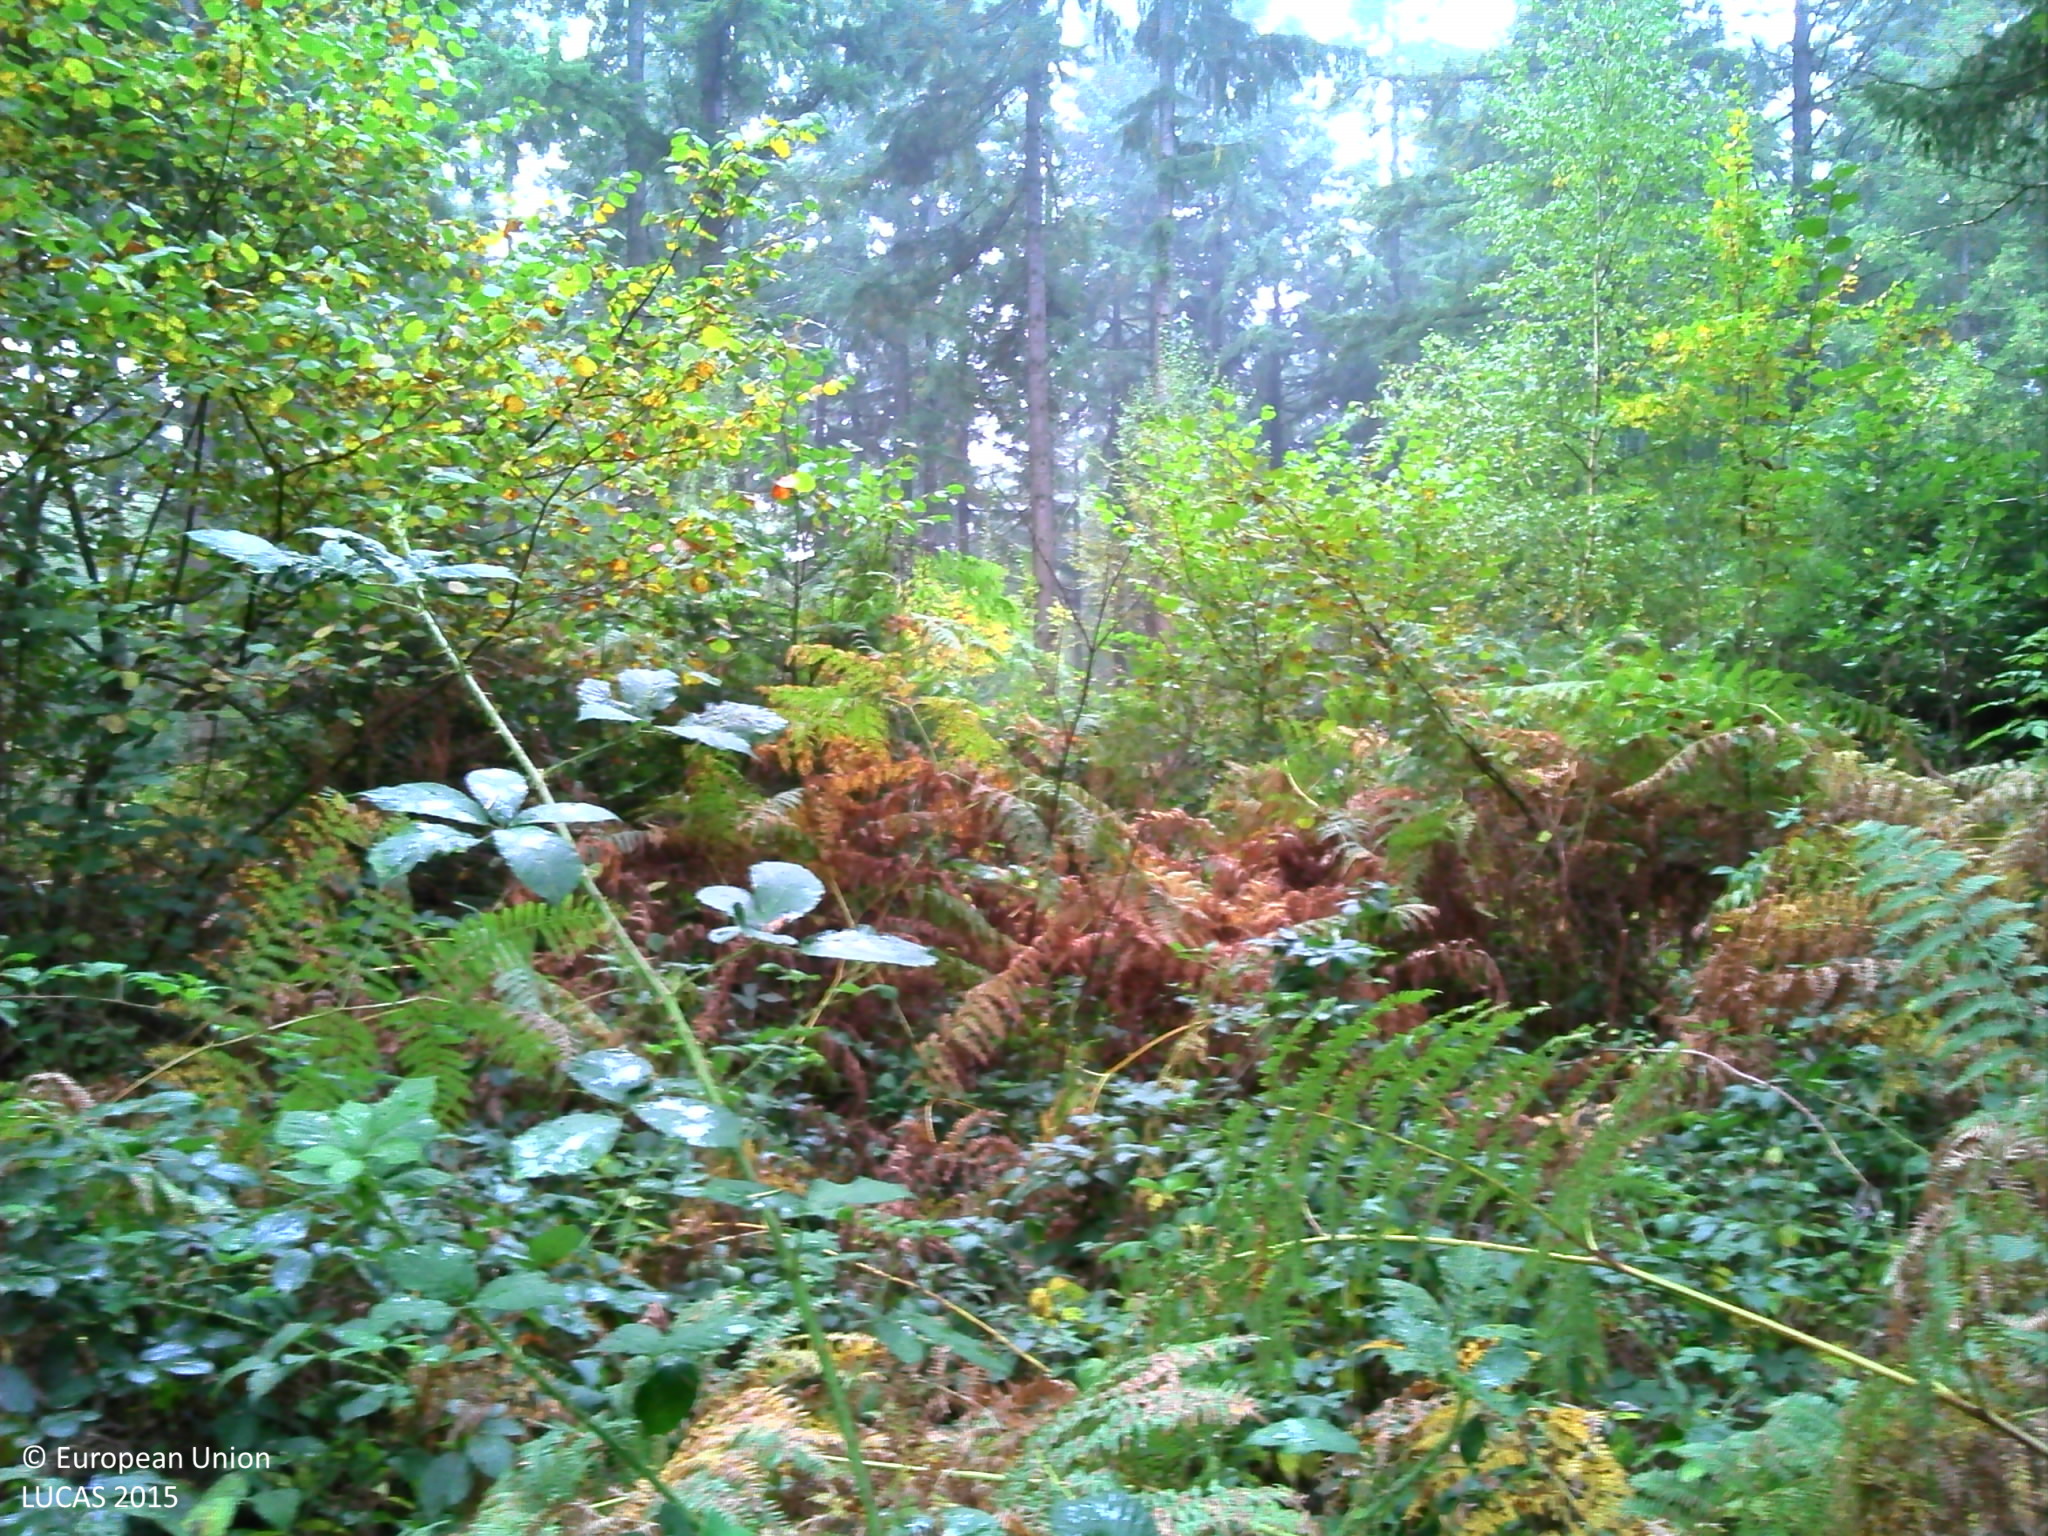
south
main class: Woodland
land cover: Other coniferous woodland
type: exotic forest
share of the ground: 50 - 75 %
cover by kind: coniferous forest trees 65 %, shrubs 20 %, broadleaved forest trees 5 %, herbaceous plants 5 %, lichens and mosses 5 %
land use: Forestry
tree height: > 5 m
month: October
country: FR
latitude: 46.1974
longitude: 2.7793
